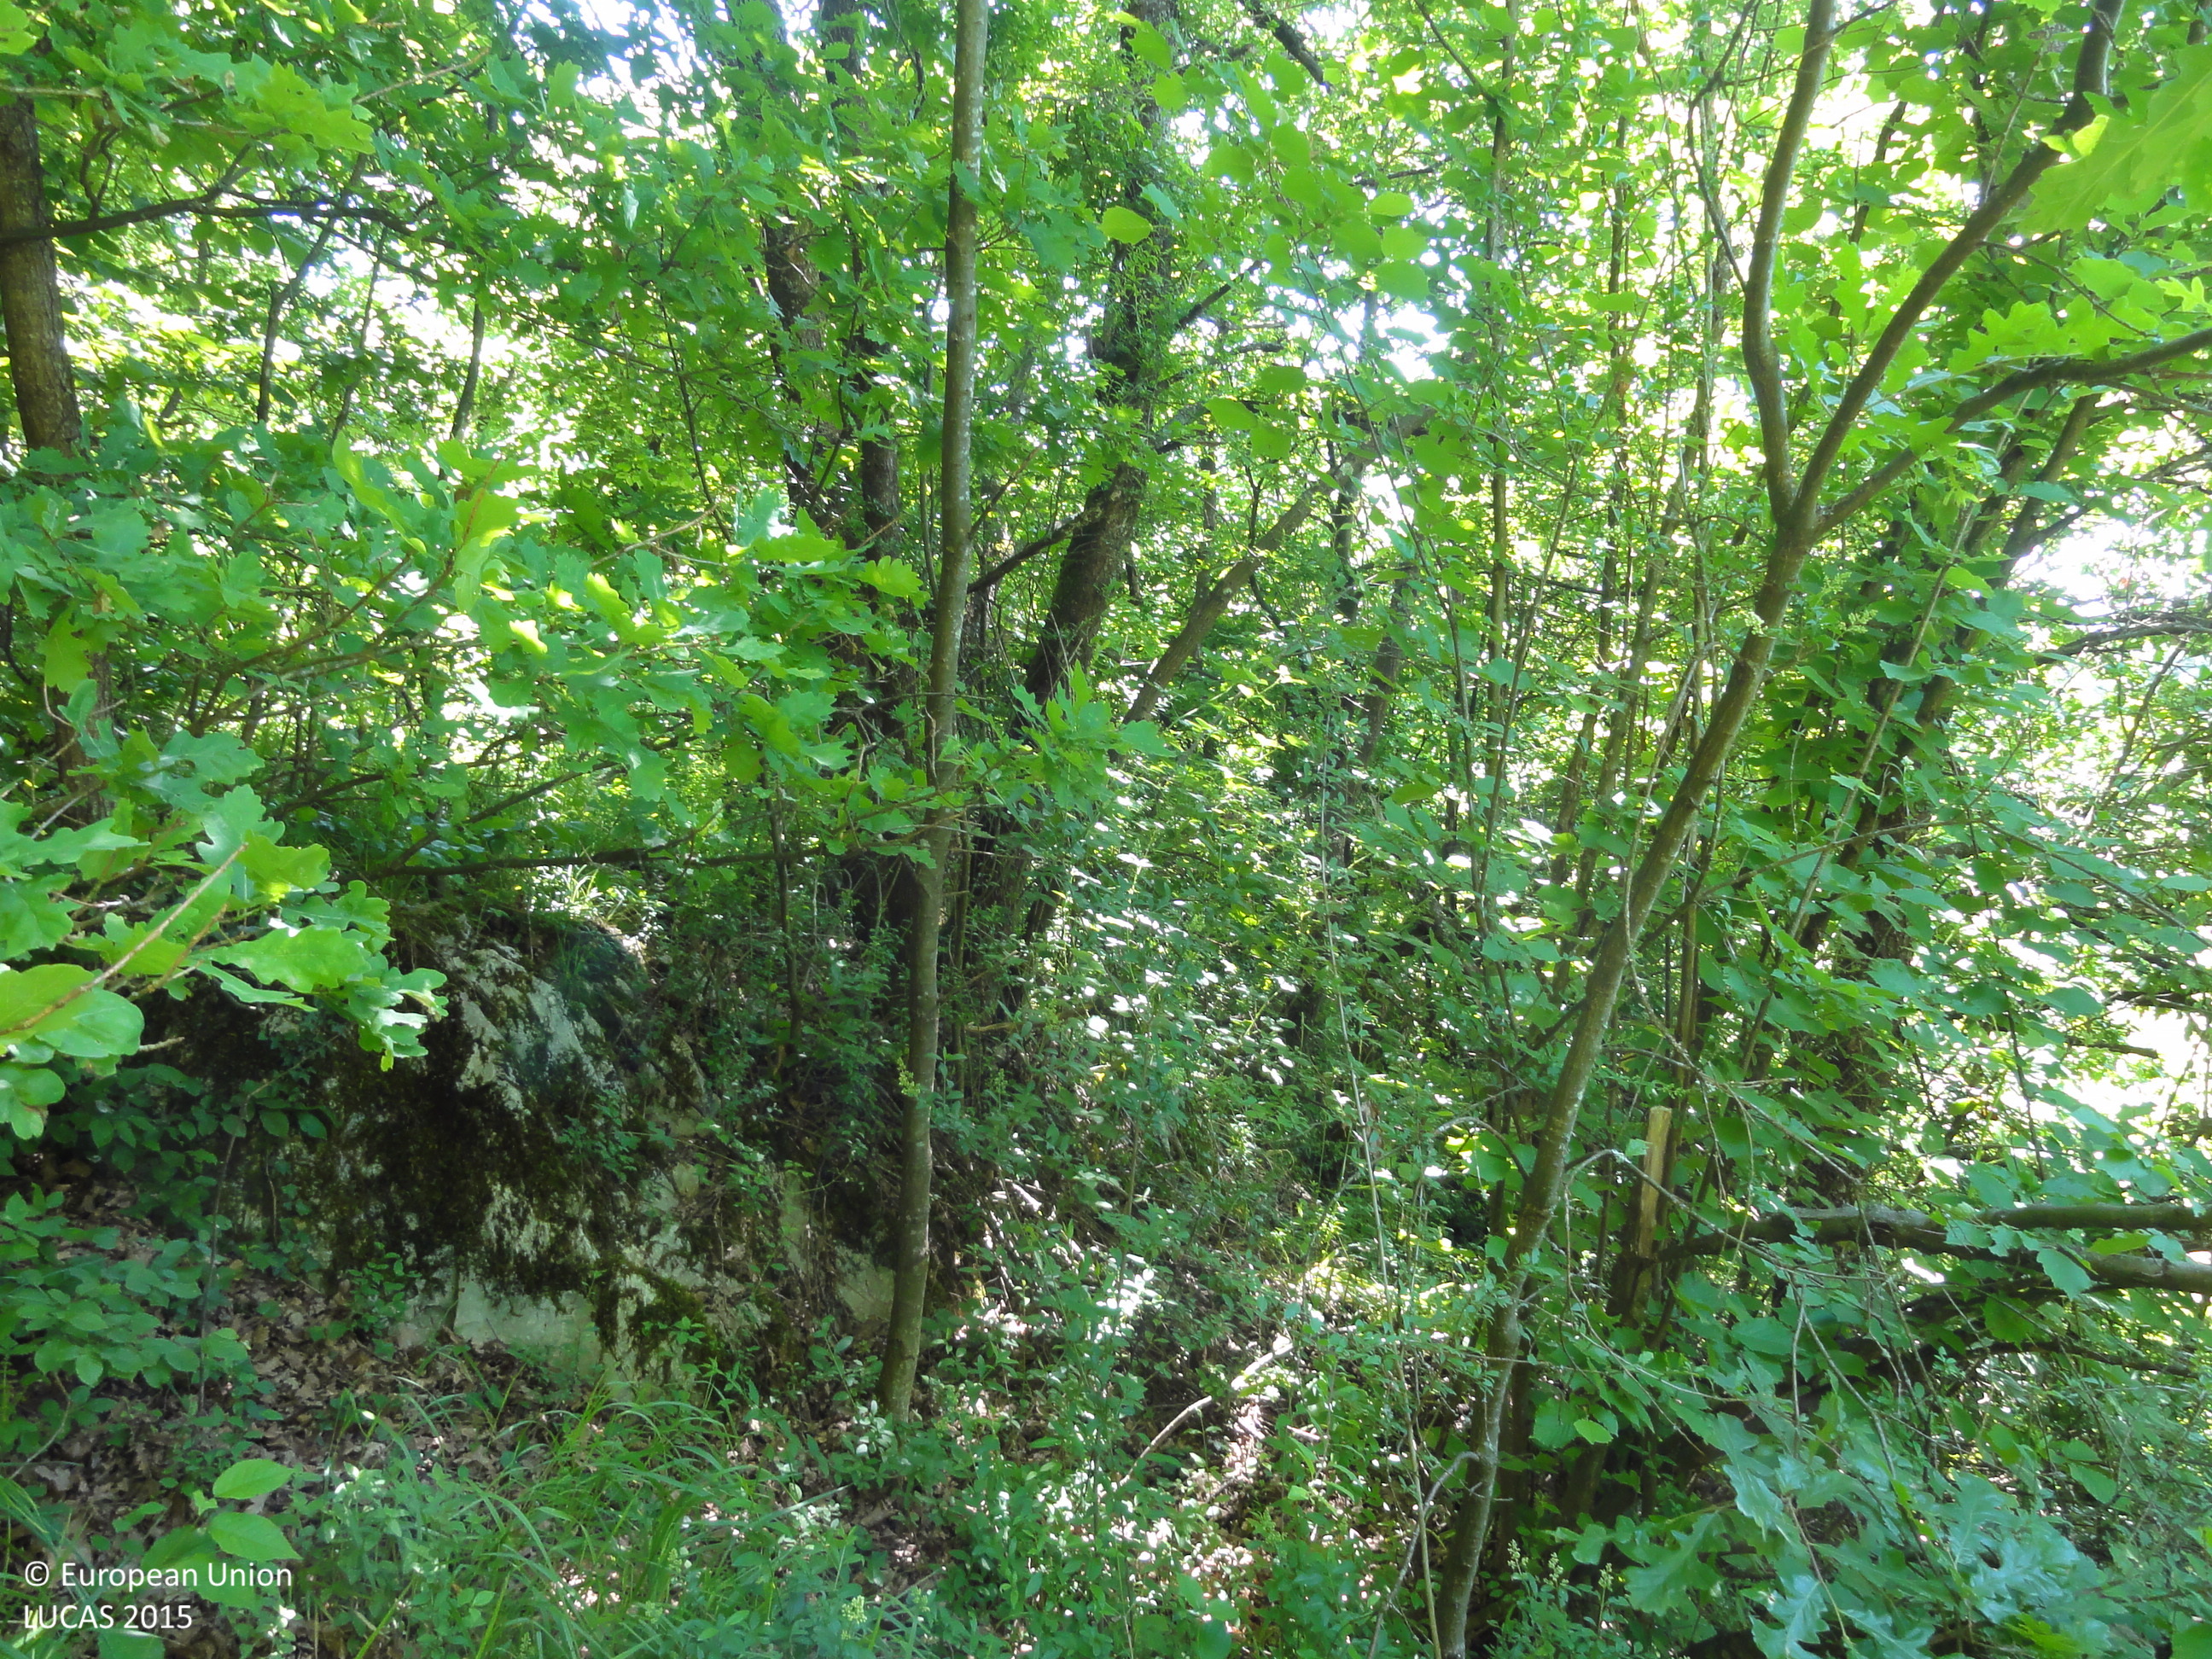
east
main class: Woodland
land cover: Broadleaved woodland
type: mesophytic deciduous forest
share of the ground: > 75 %
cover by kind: broadleaved forest trees 100 %
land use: Semi-natural and natural areas not in use
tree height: > 5 m
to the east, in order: Broadleaved woodland; Grassland without tree/shrub cover; Barley; Electric lines; Barley; Grass margins; Temporary grasslands
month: May
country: SI
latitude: 45.8730
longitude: 15.0080
